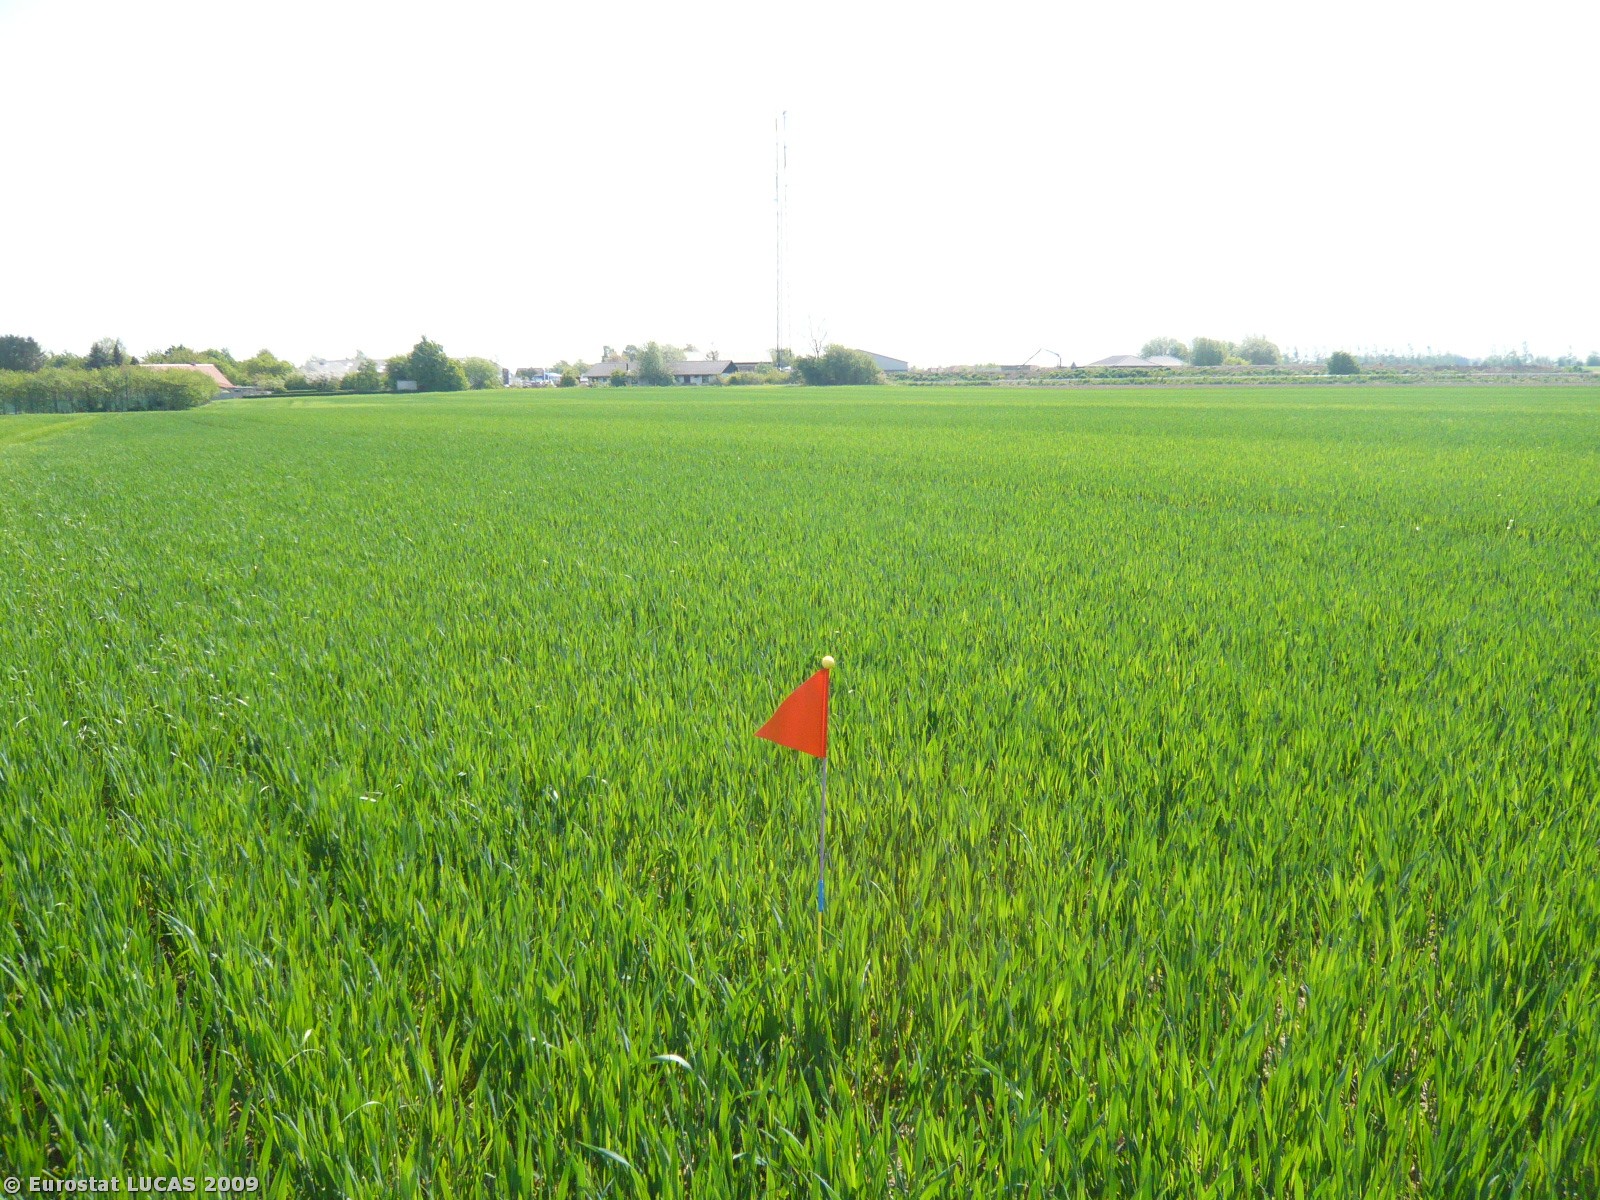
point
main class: Cropland
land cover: Common wheat
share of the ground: > 75 %
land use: Agriculture (excluding fallow land and kitchen gardens)
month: May
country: DK
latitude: 55.3060
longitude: 12.1881
